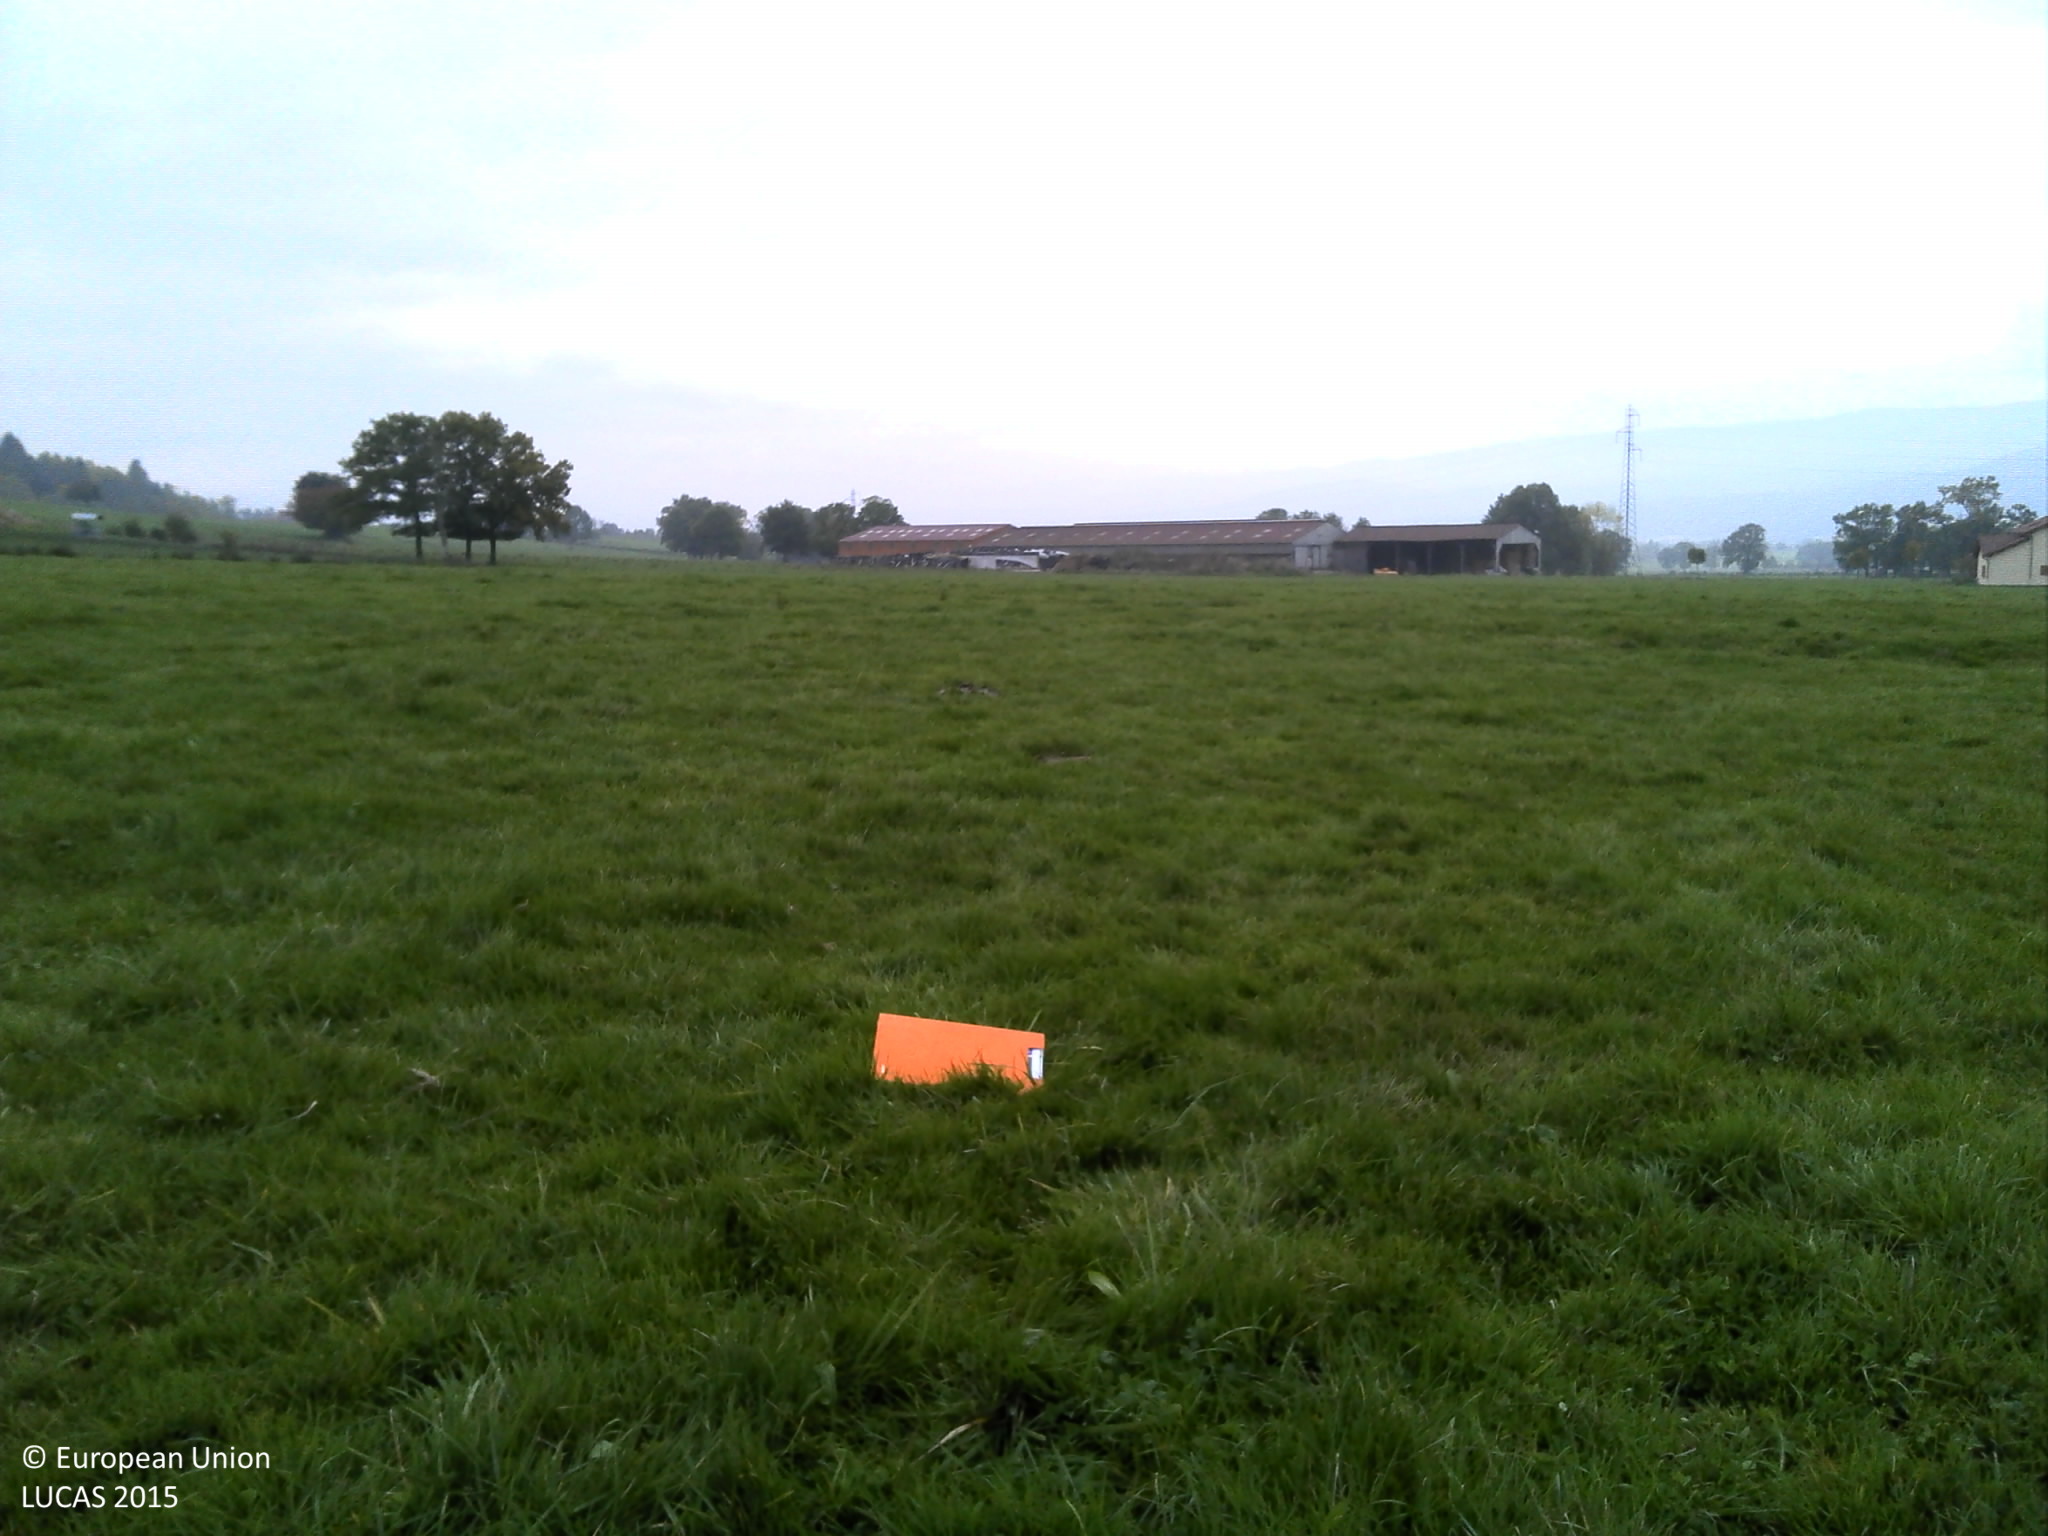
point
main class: Grassland
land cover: Grassland without tree/shrub cover
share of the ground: > 75 %
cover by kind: herbaceous plants 100 %
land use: Agriculture (excluding fallow land and kitchen gardens)
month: October
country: FR
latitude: 45.5370
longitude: 3.7658
